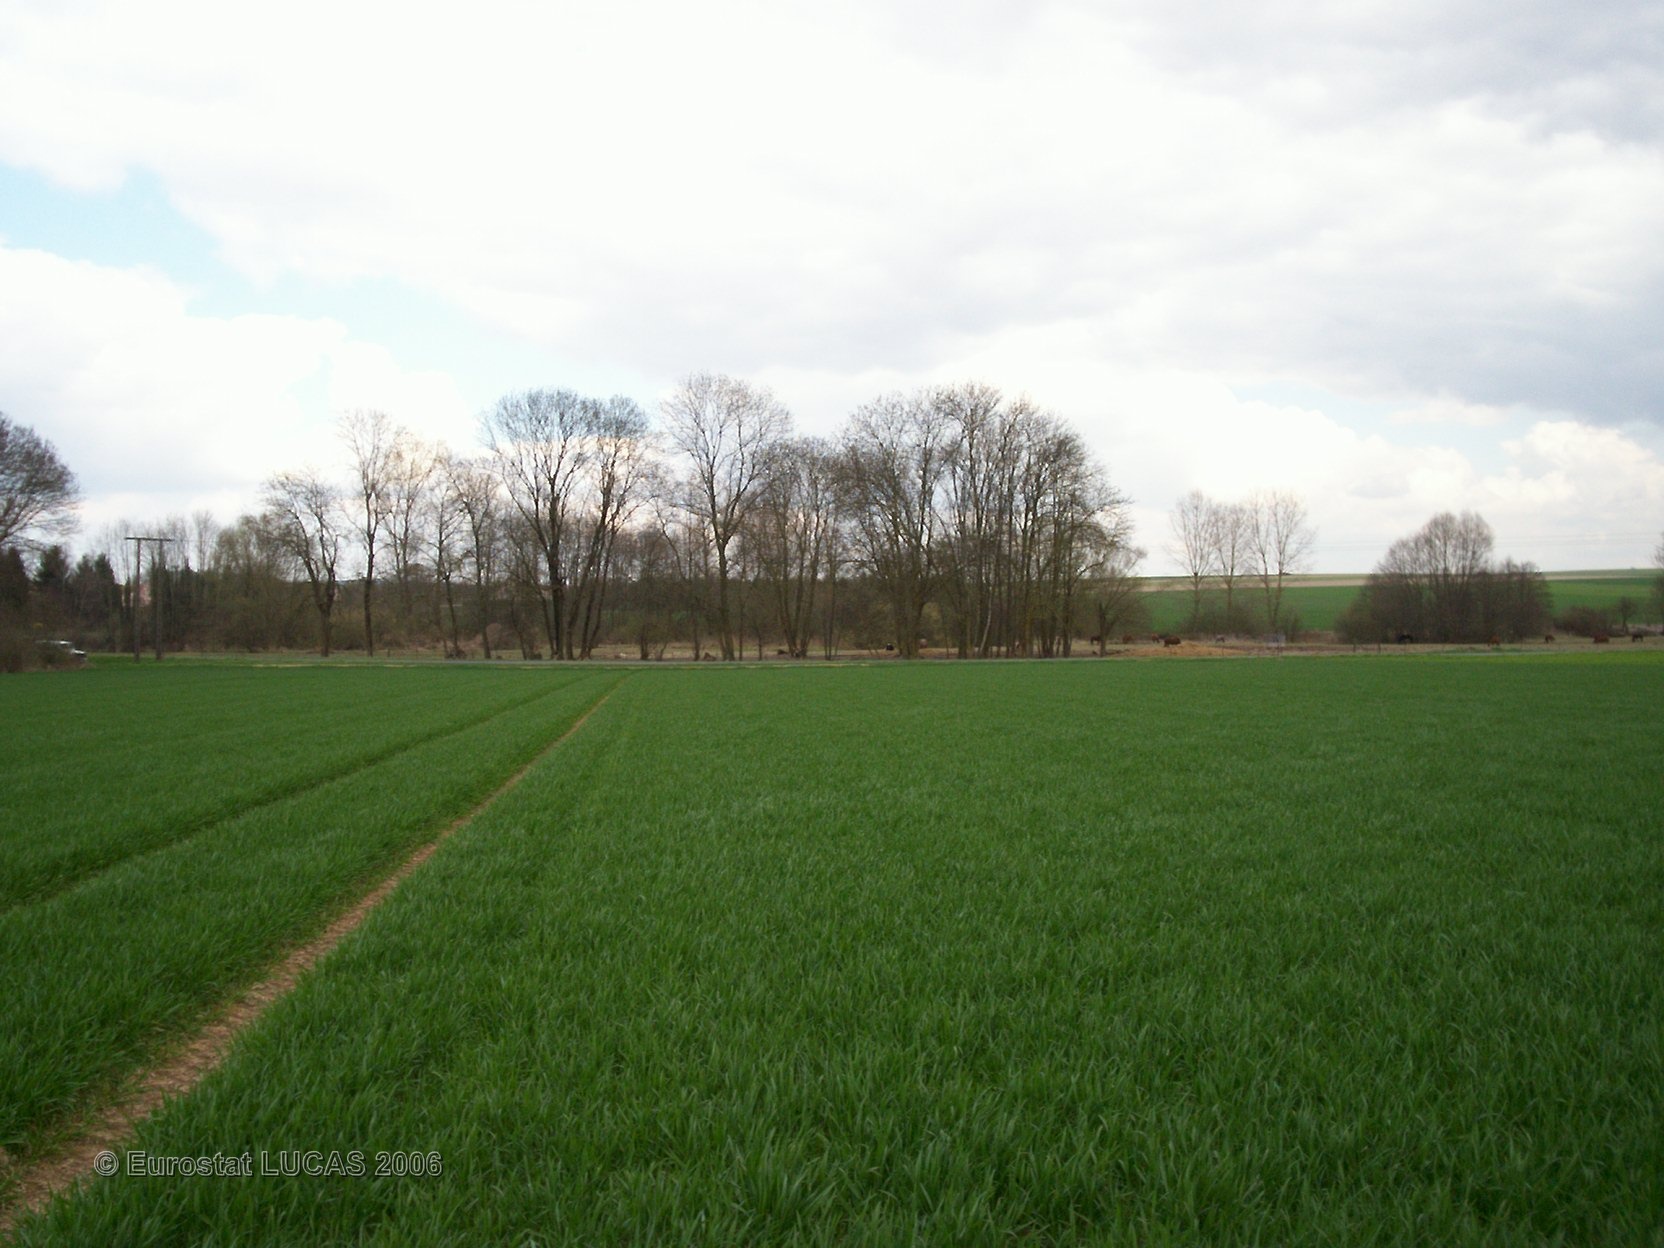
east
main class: Cropland
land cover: Common wheat
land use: Agriculture (excluding fallow land and kitchen gardens)
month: April
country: FR
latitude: 49.2357
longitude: 4.4065
